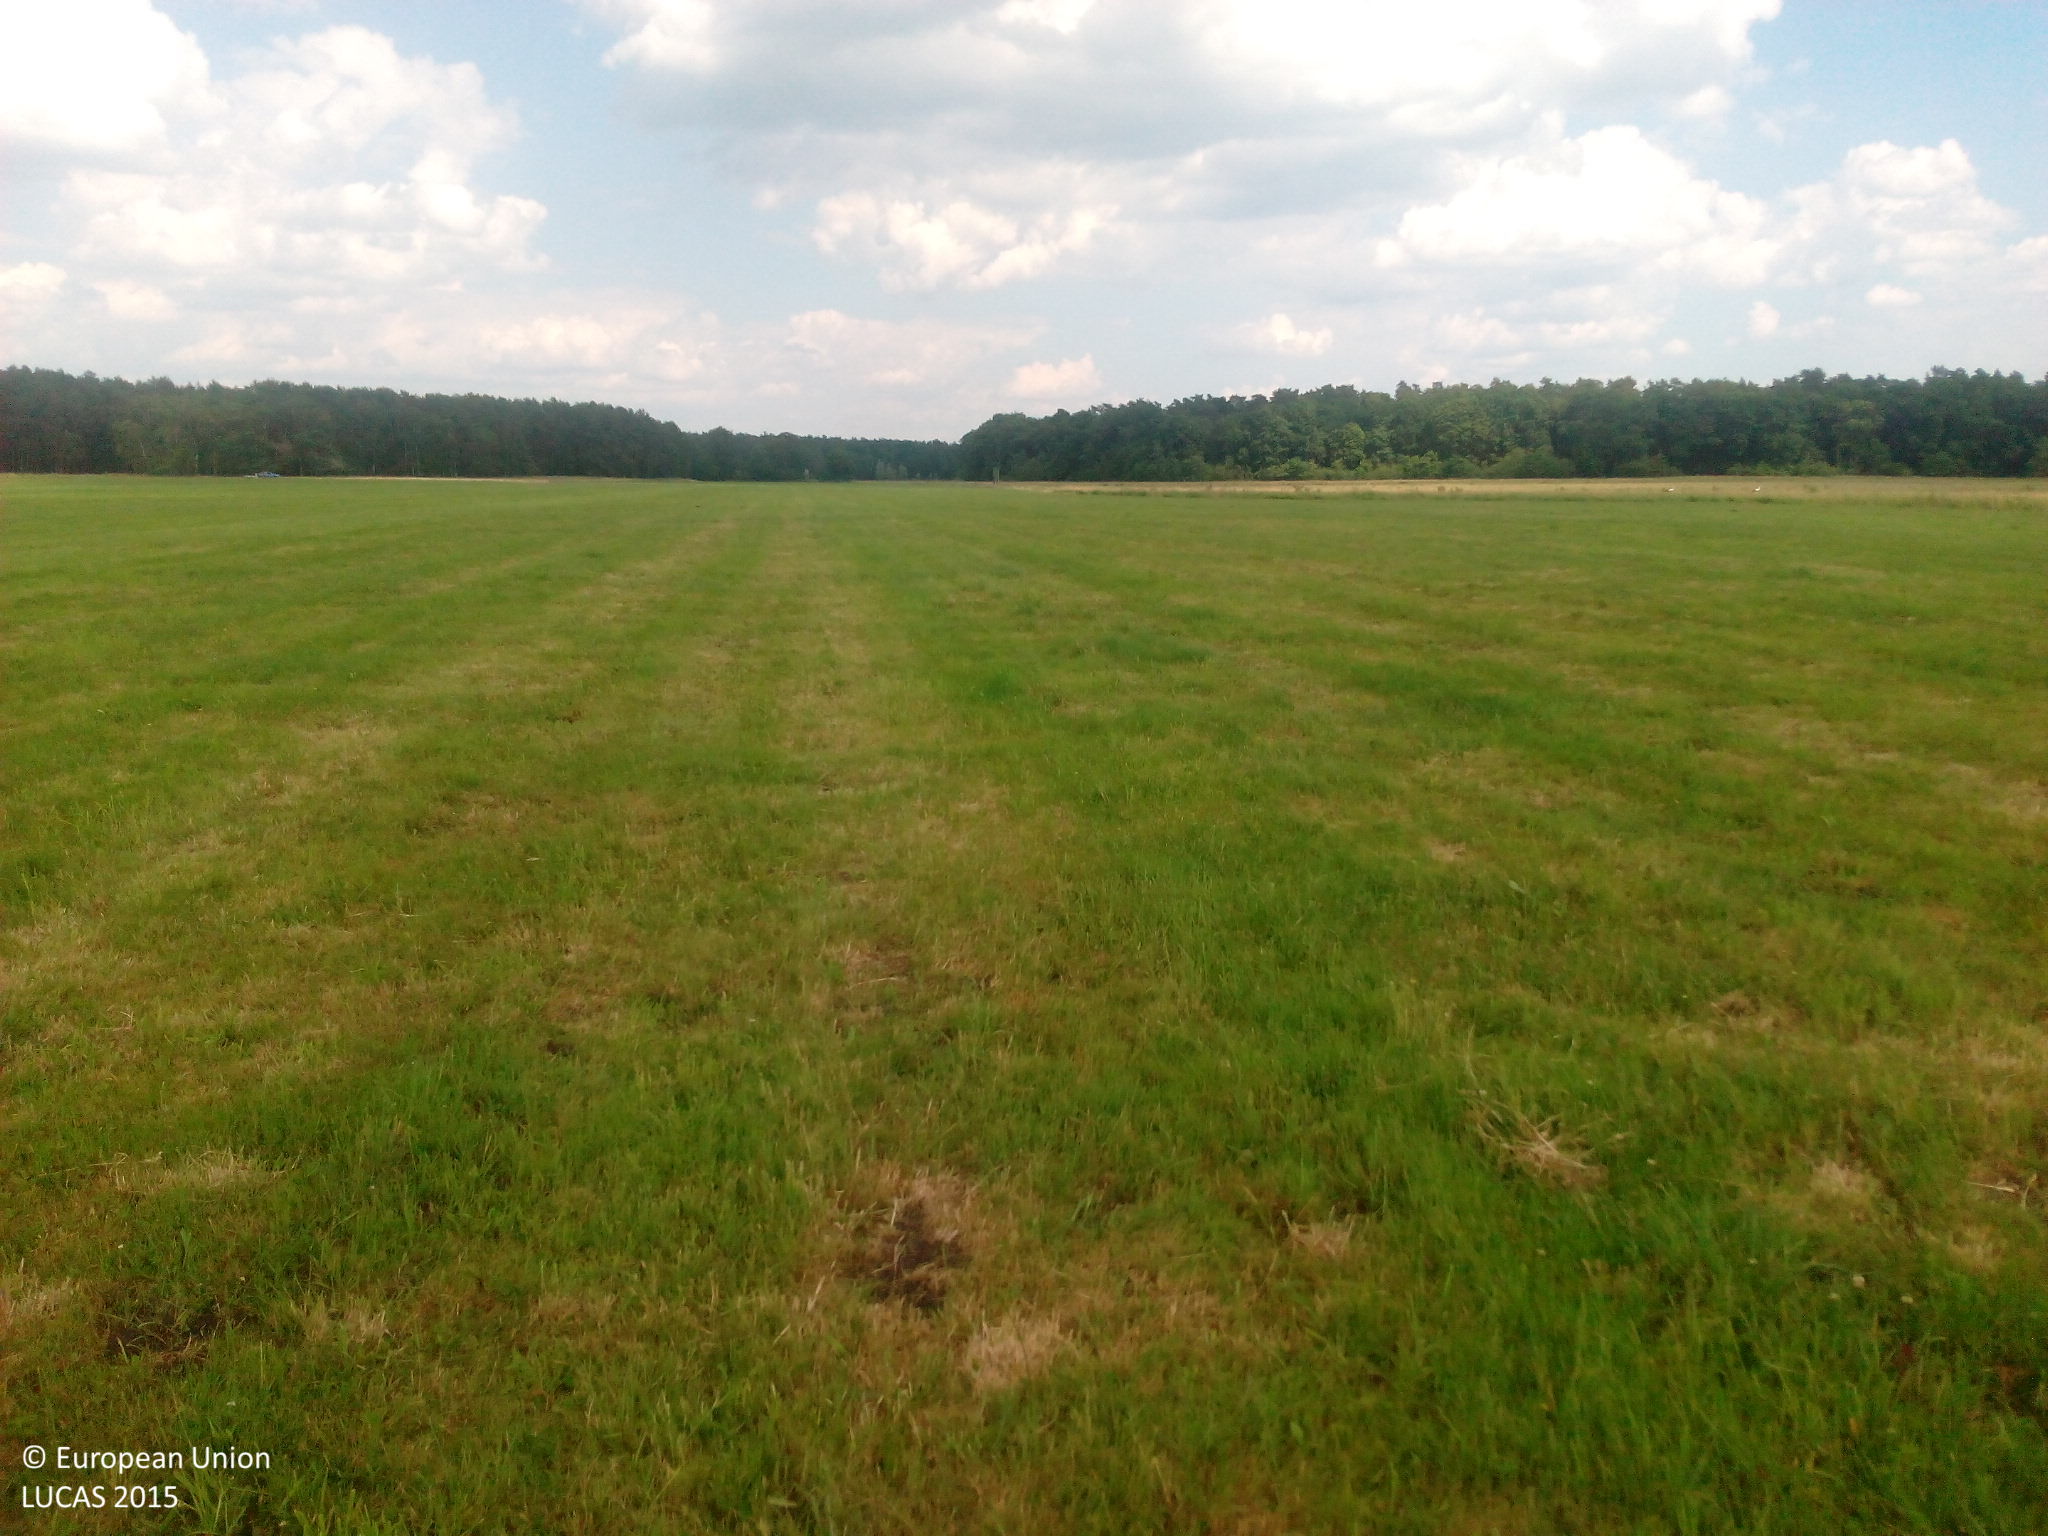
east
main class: Grassland
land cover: Grassland without tree/shrub cover
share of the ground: > 75 %
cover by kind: herbaceous plants 100 %
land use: Agriculture (excluding fallow land and kitchen gardens)
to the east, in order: Grassland without tree/shrub cover; Ditches and canals; Fences; Grassland without tree/shrub cover
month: June
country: DE
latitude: 52.8750
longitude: 13.1645
